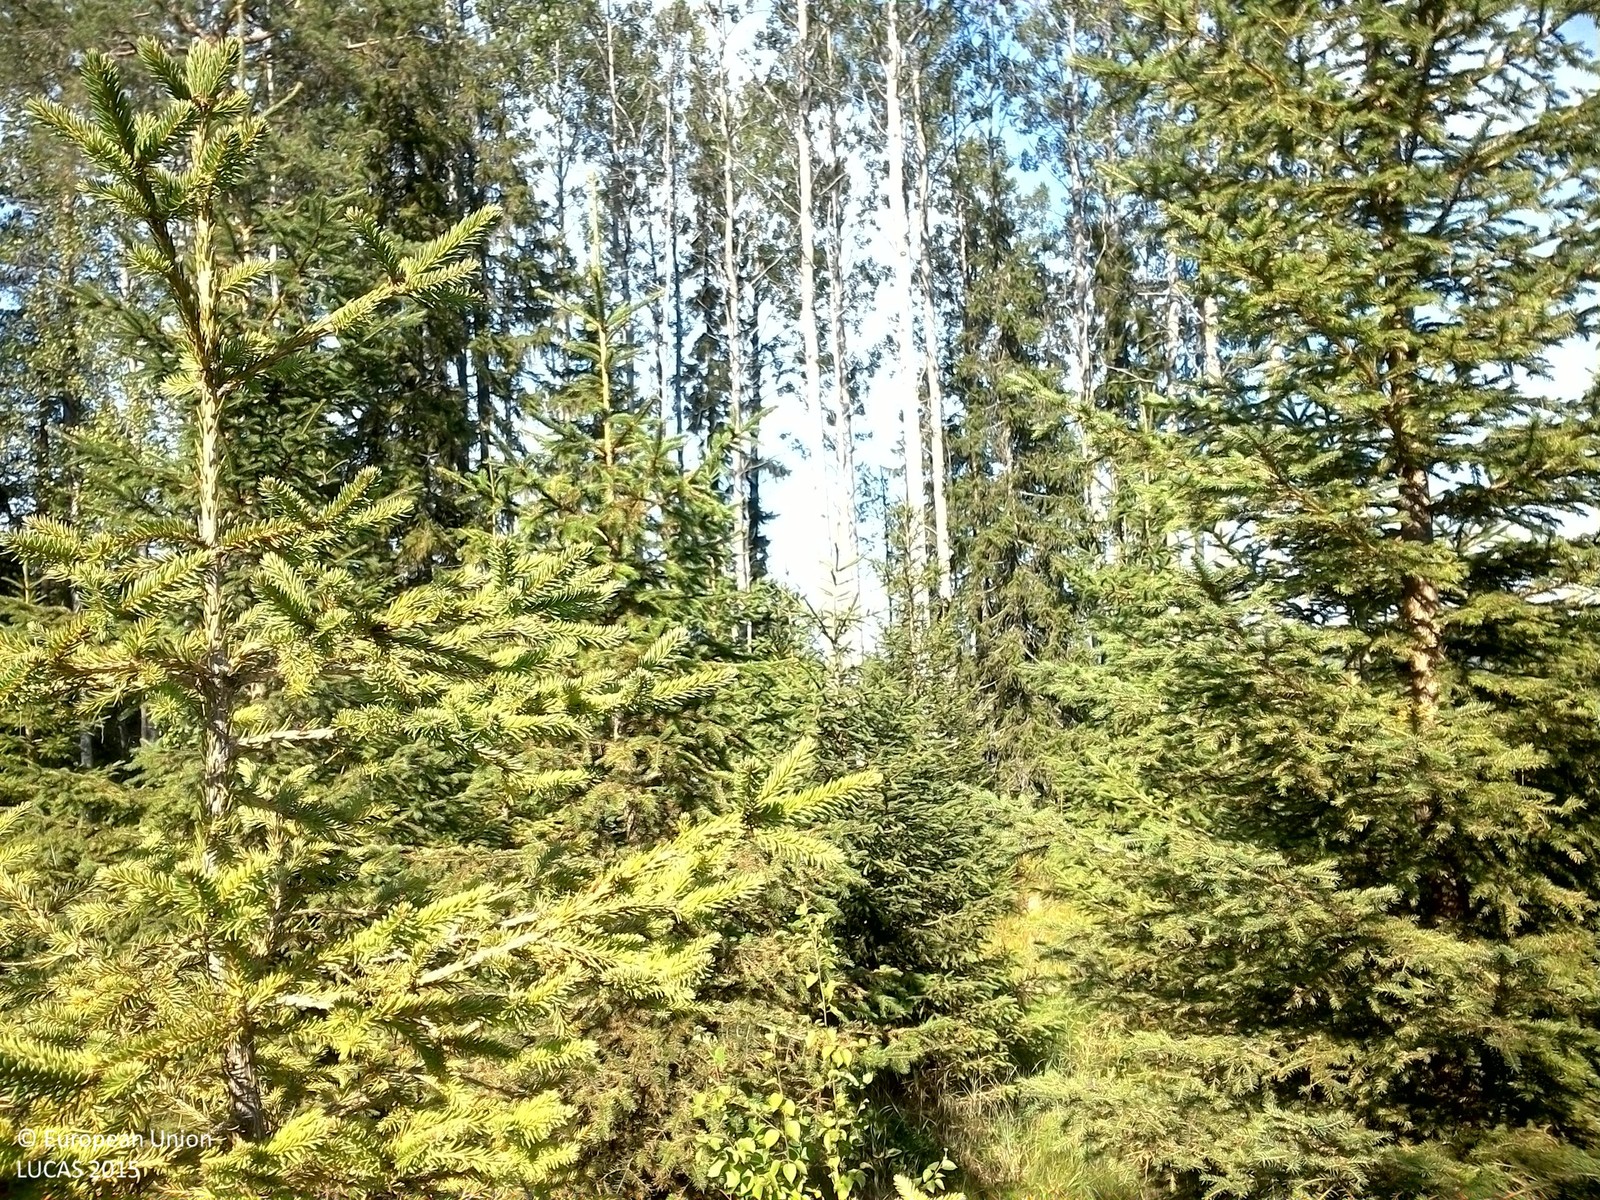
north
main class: Woodland
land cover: Spruce dominated mixed woodland
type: boreal forest
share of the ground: 50 - 75 %
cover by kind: coniferous forest trees 50 %, broadleaved forest trees 20 %, shrubs 10 %, herbaceous plants 10 %, lichens and mosses 10 %
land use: Forestry
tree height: < 5 m
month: August
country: SE
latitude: 63.8051
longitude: 17.4643
